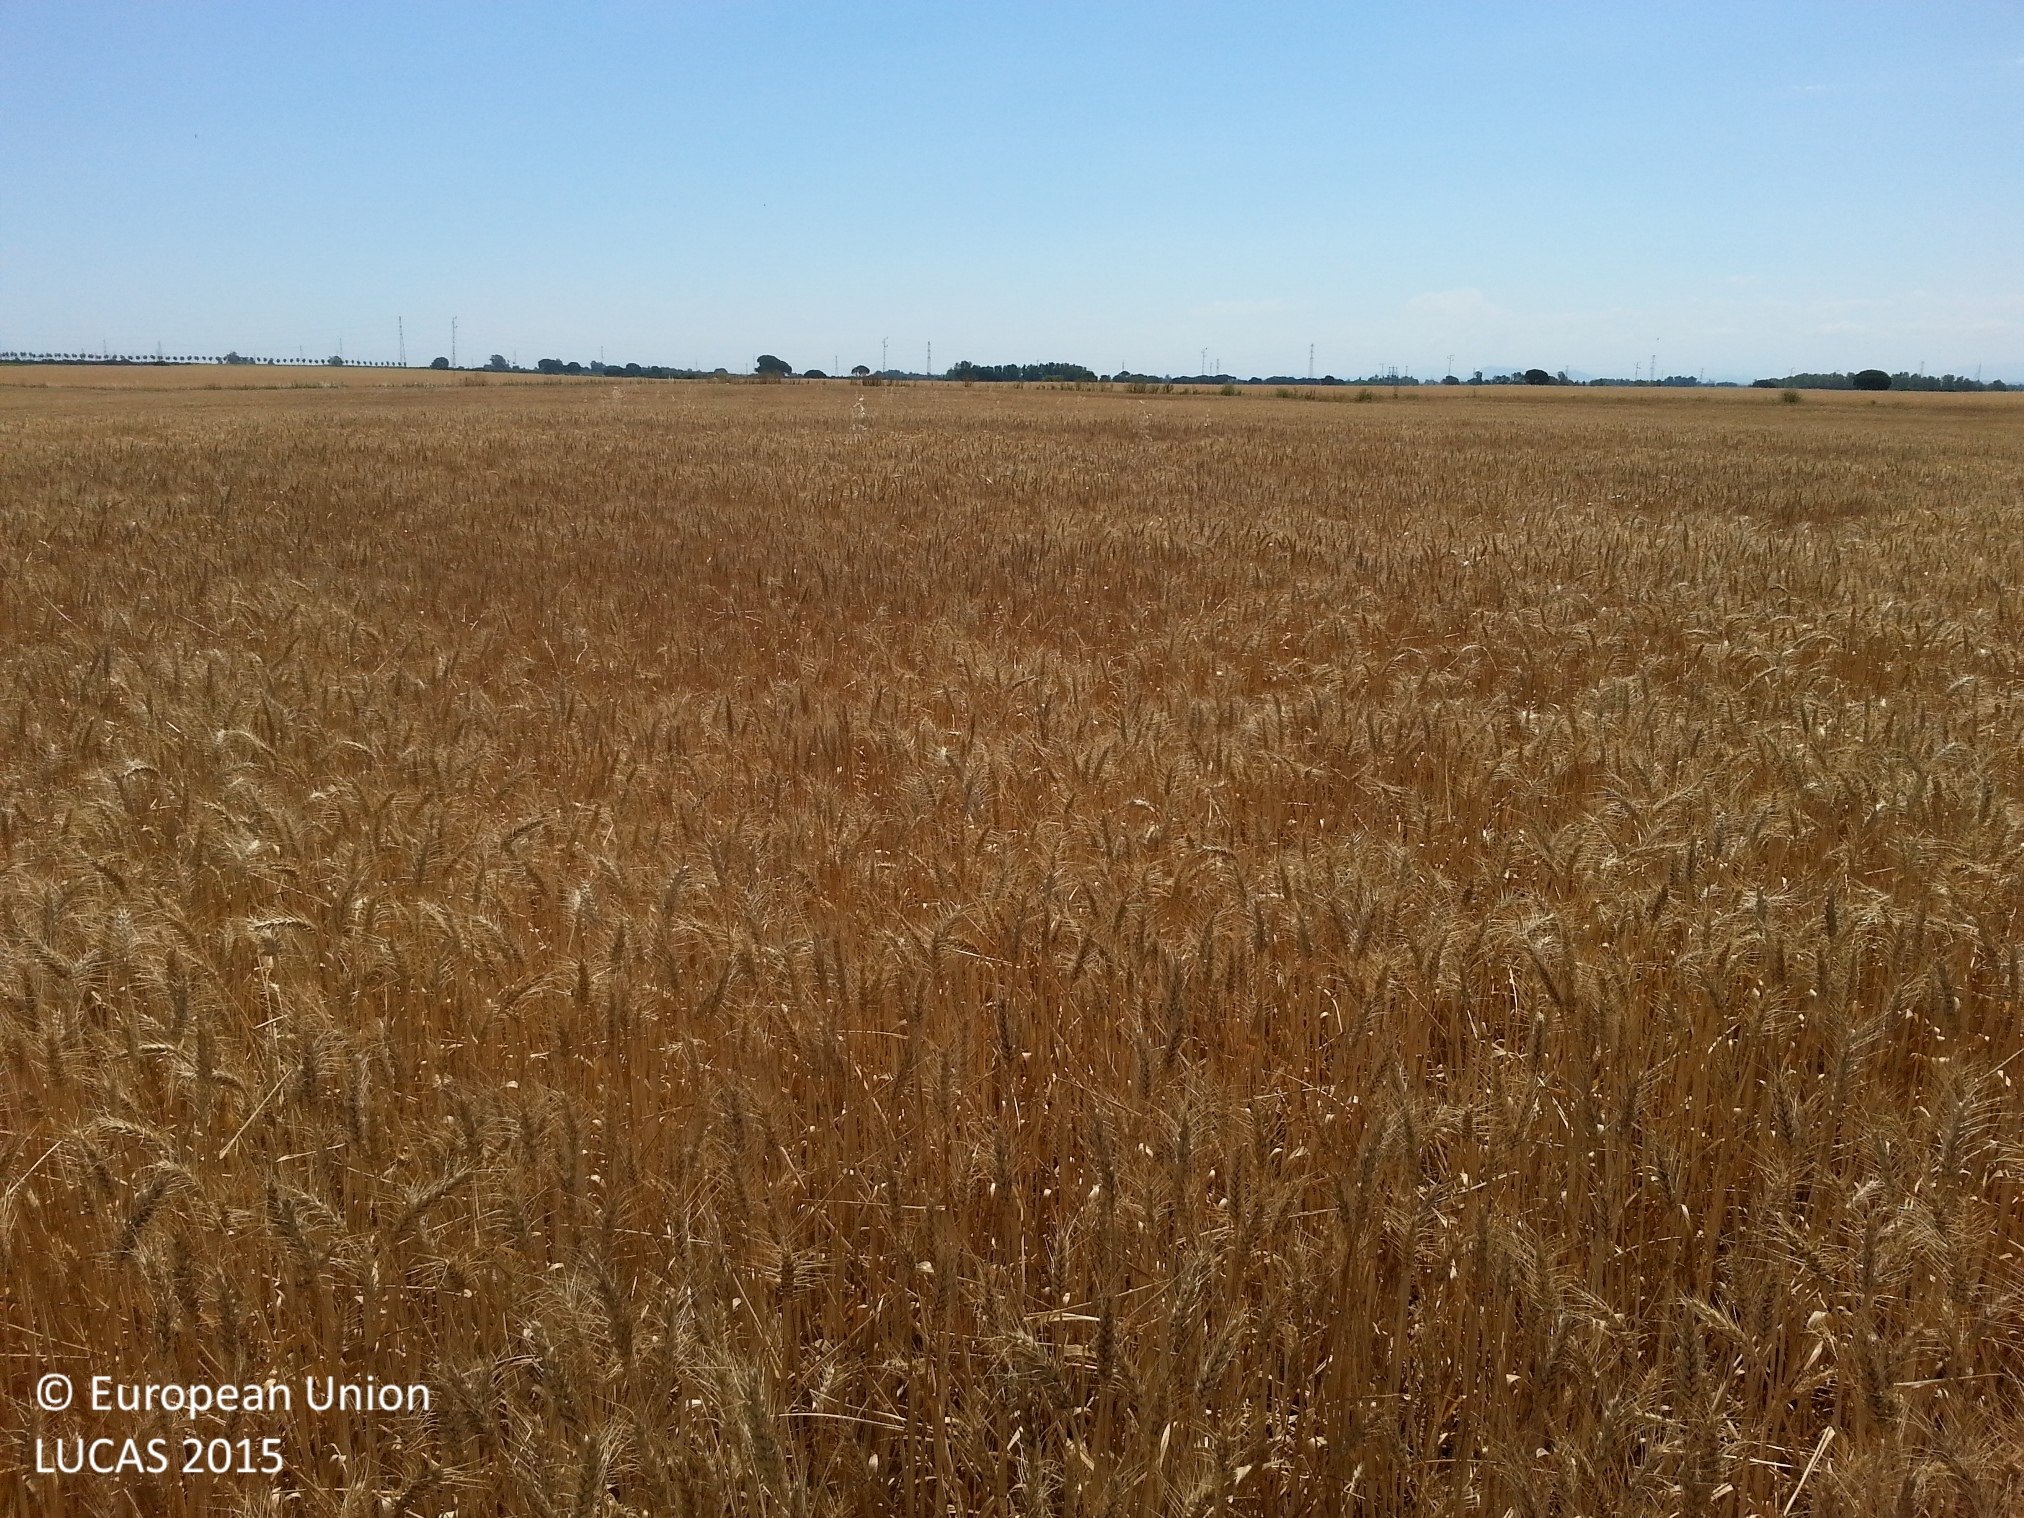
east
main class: Cropland
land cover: Durum wheat
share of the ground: > 75 %
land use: Agriculture (excluding fallow land and kitchen gardens)
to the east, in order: Durum wheat; Ditches and canals; Arable land (only in case pi)
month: May
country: ES
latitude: 37.2339
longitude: -5.8781
